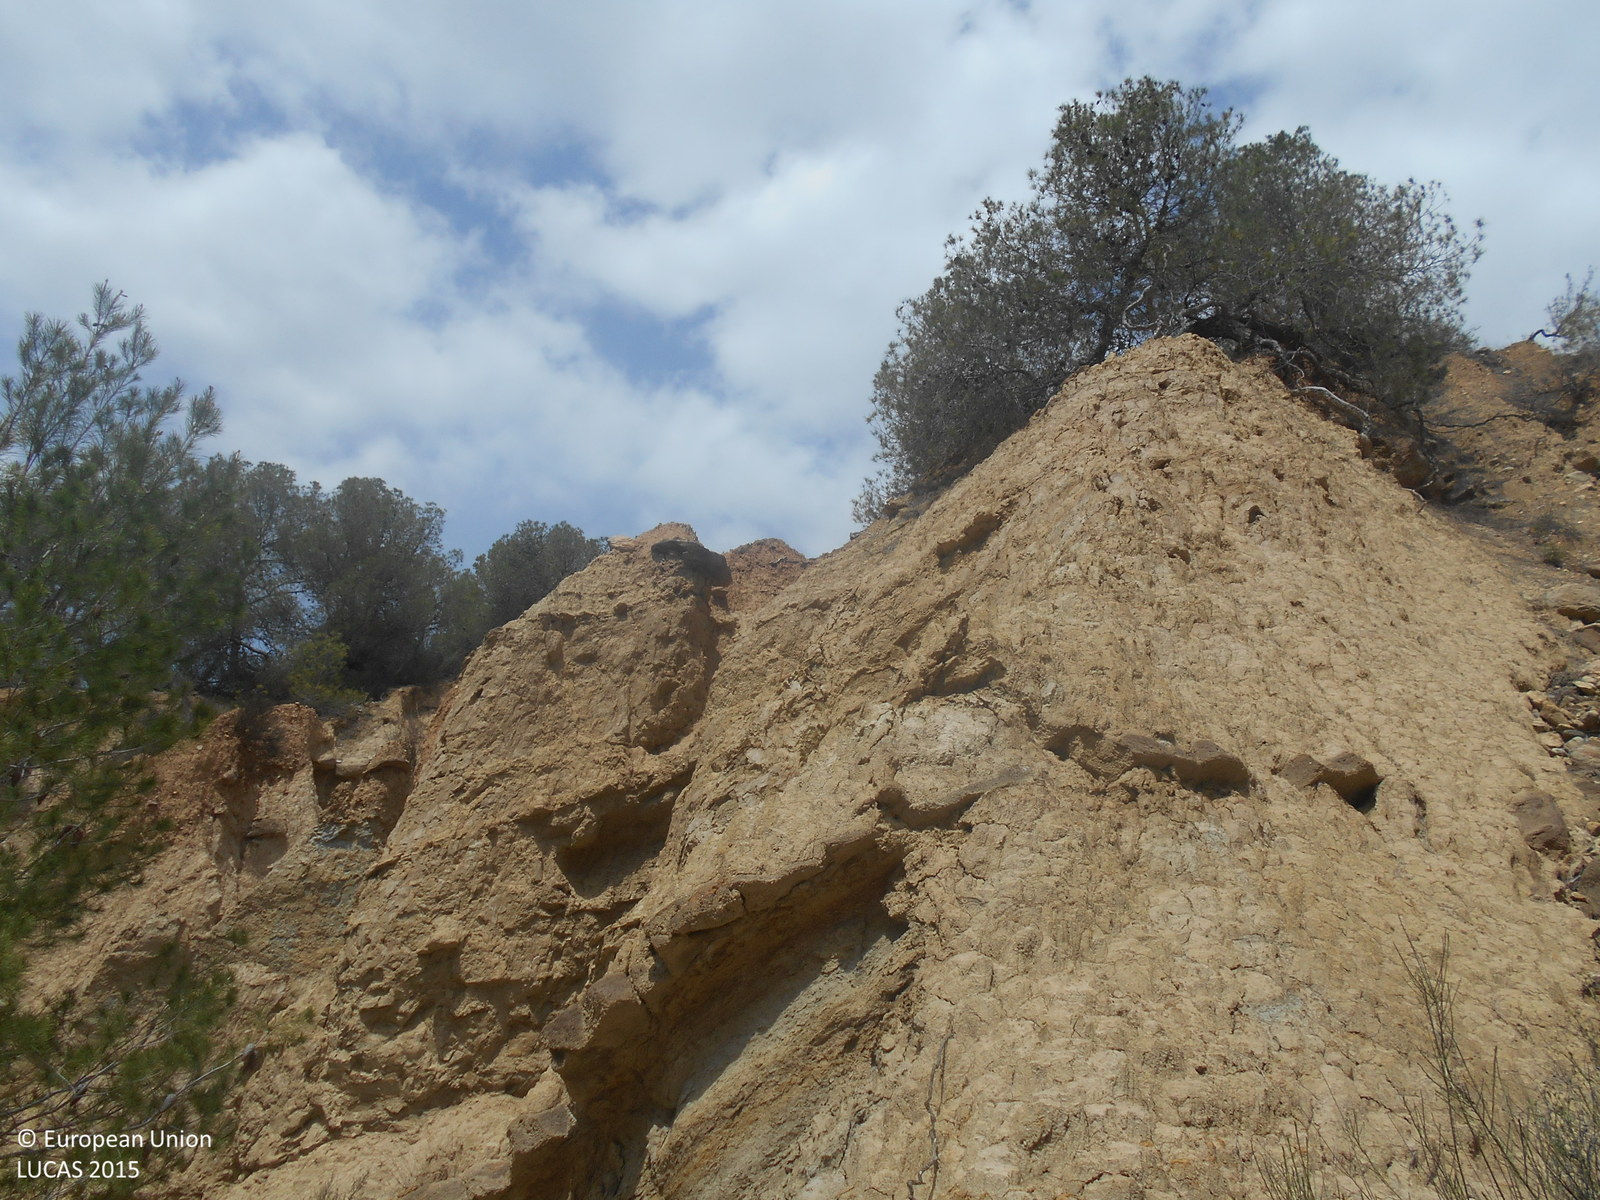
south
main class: Woodland
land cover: Pine dominated coniferous woodland
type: coniferous forest of the mediterranean region
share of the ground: 10 - 25 %
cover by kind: unconsolidated bare surface 40 %, shrubs 30 %, coniferous forest trees 20 %, consolidated bare surface 10 %
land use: Semi-natural and natural areas not in use
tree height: > 5 m
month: April
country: ES
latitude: 37.6503
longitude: -1.5083
